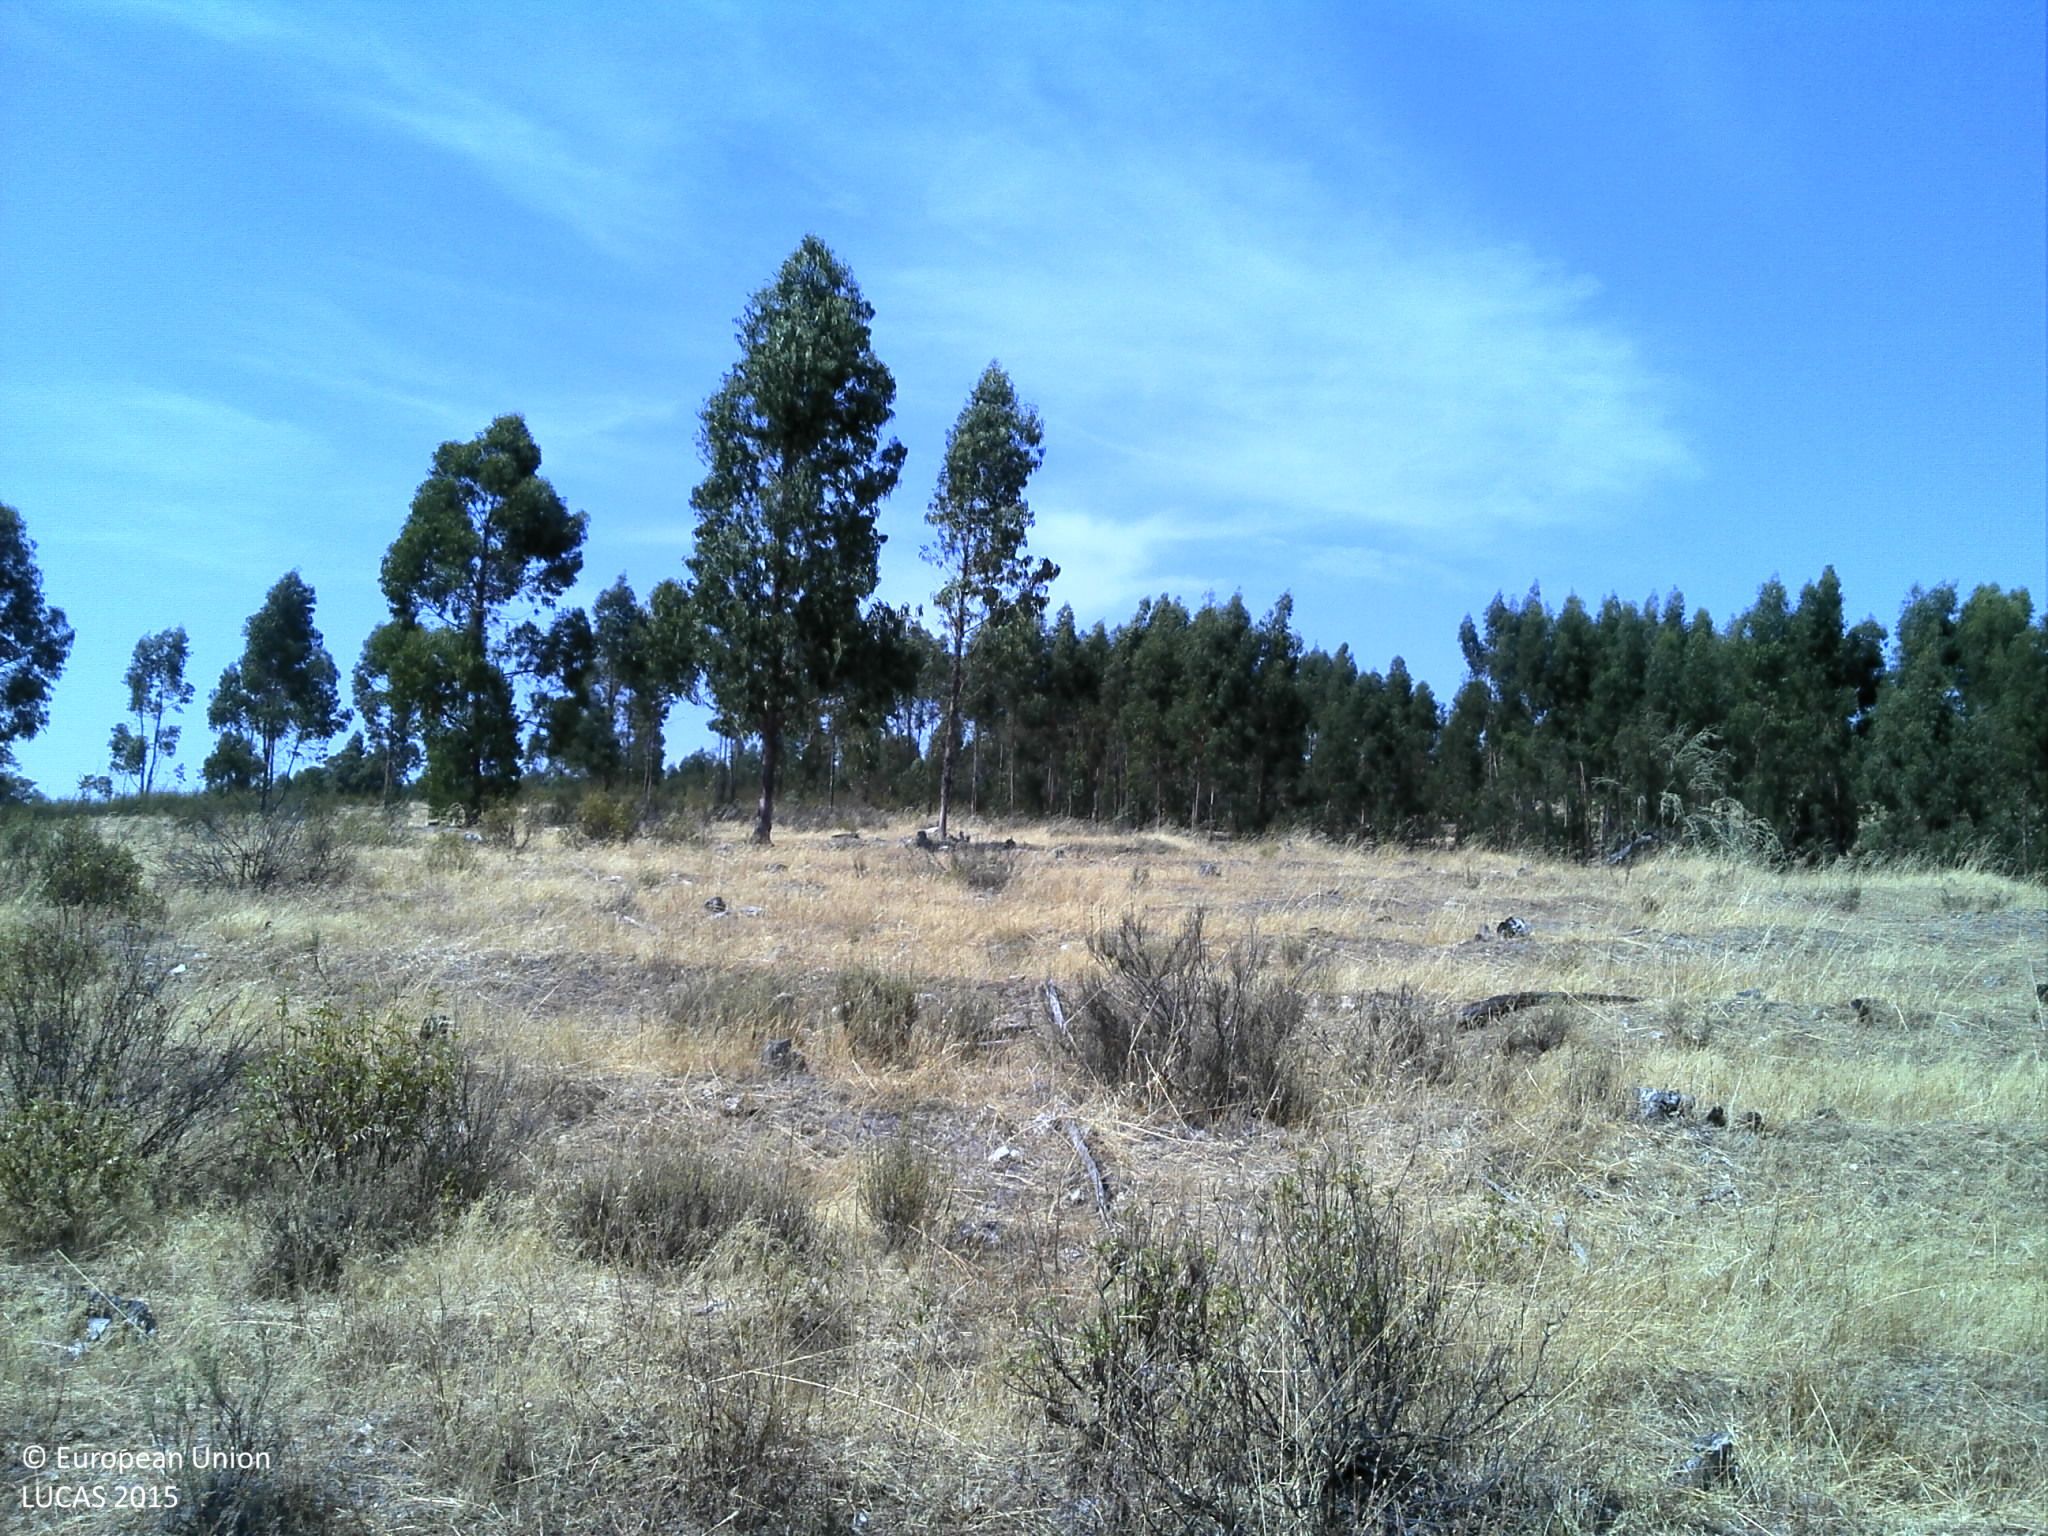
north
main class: Shrubland
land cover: Shrubland without tree cover
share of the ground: 25 - 50 %
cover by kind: herbaceous plants 60 %, shrubs 25 %, unconsolidated bare surface 15 %
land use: Agriculture (excluding fallow land and kitchen gardens)
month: July
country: PT
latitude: 38.6642
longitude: -7.4885
